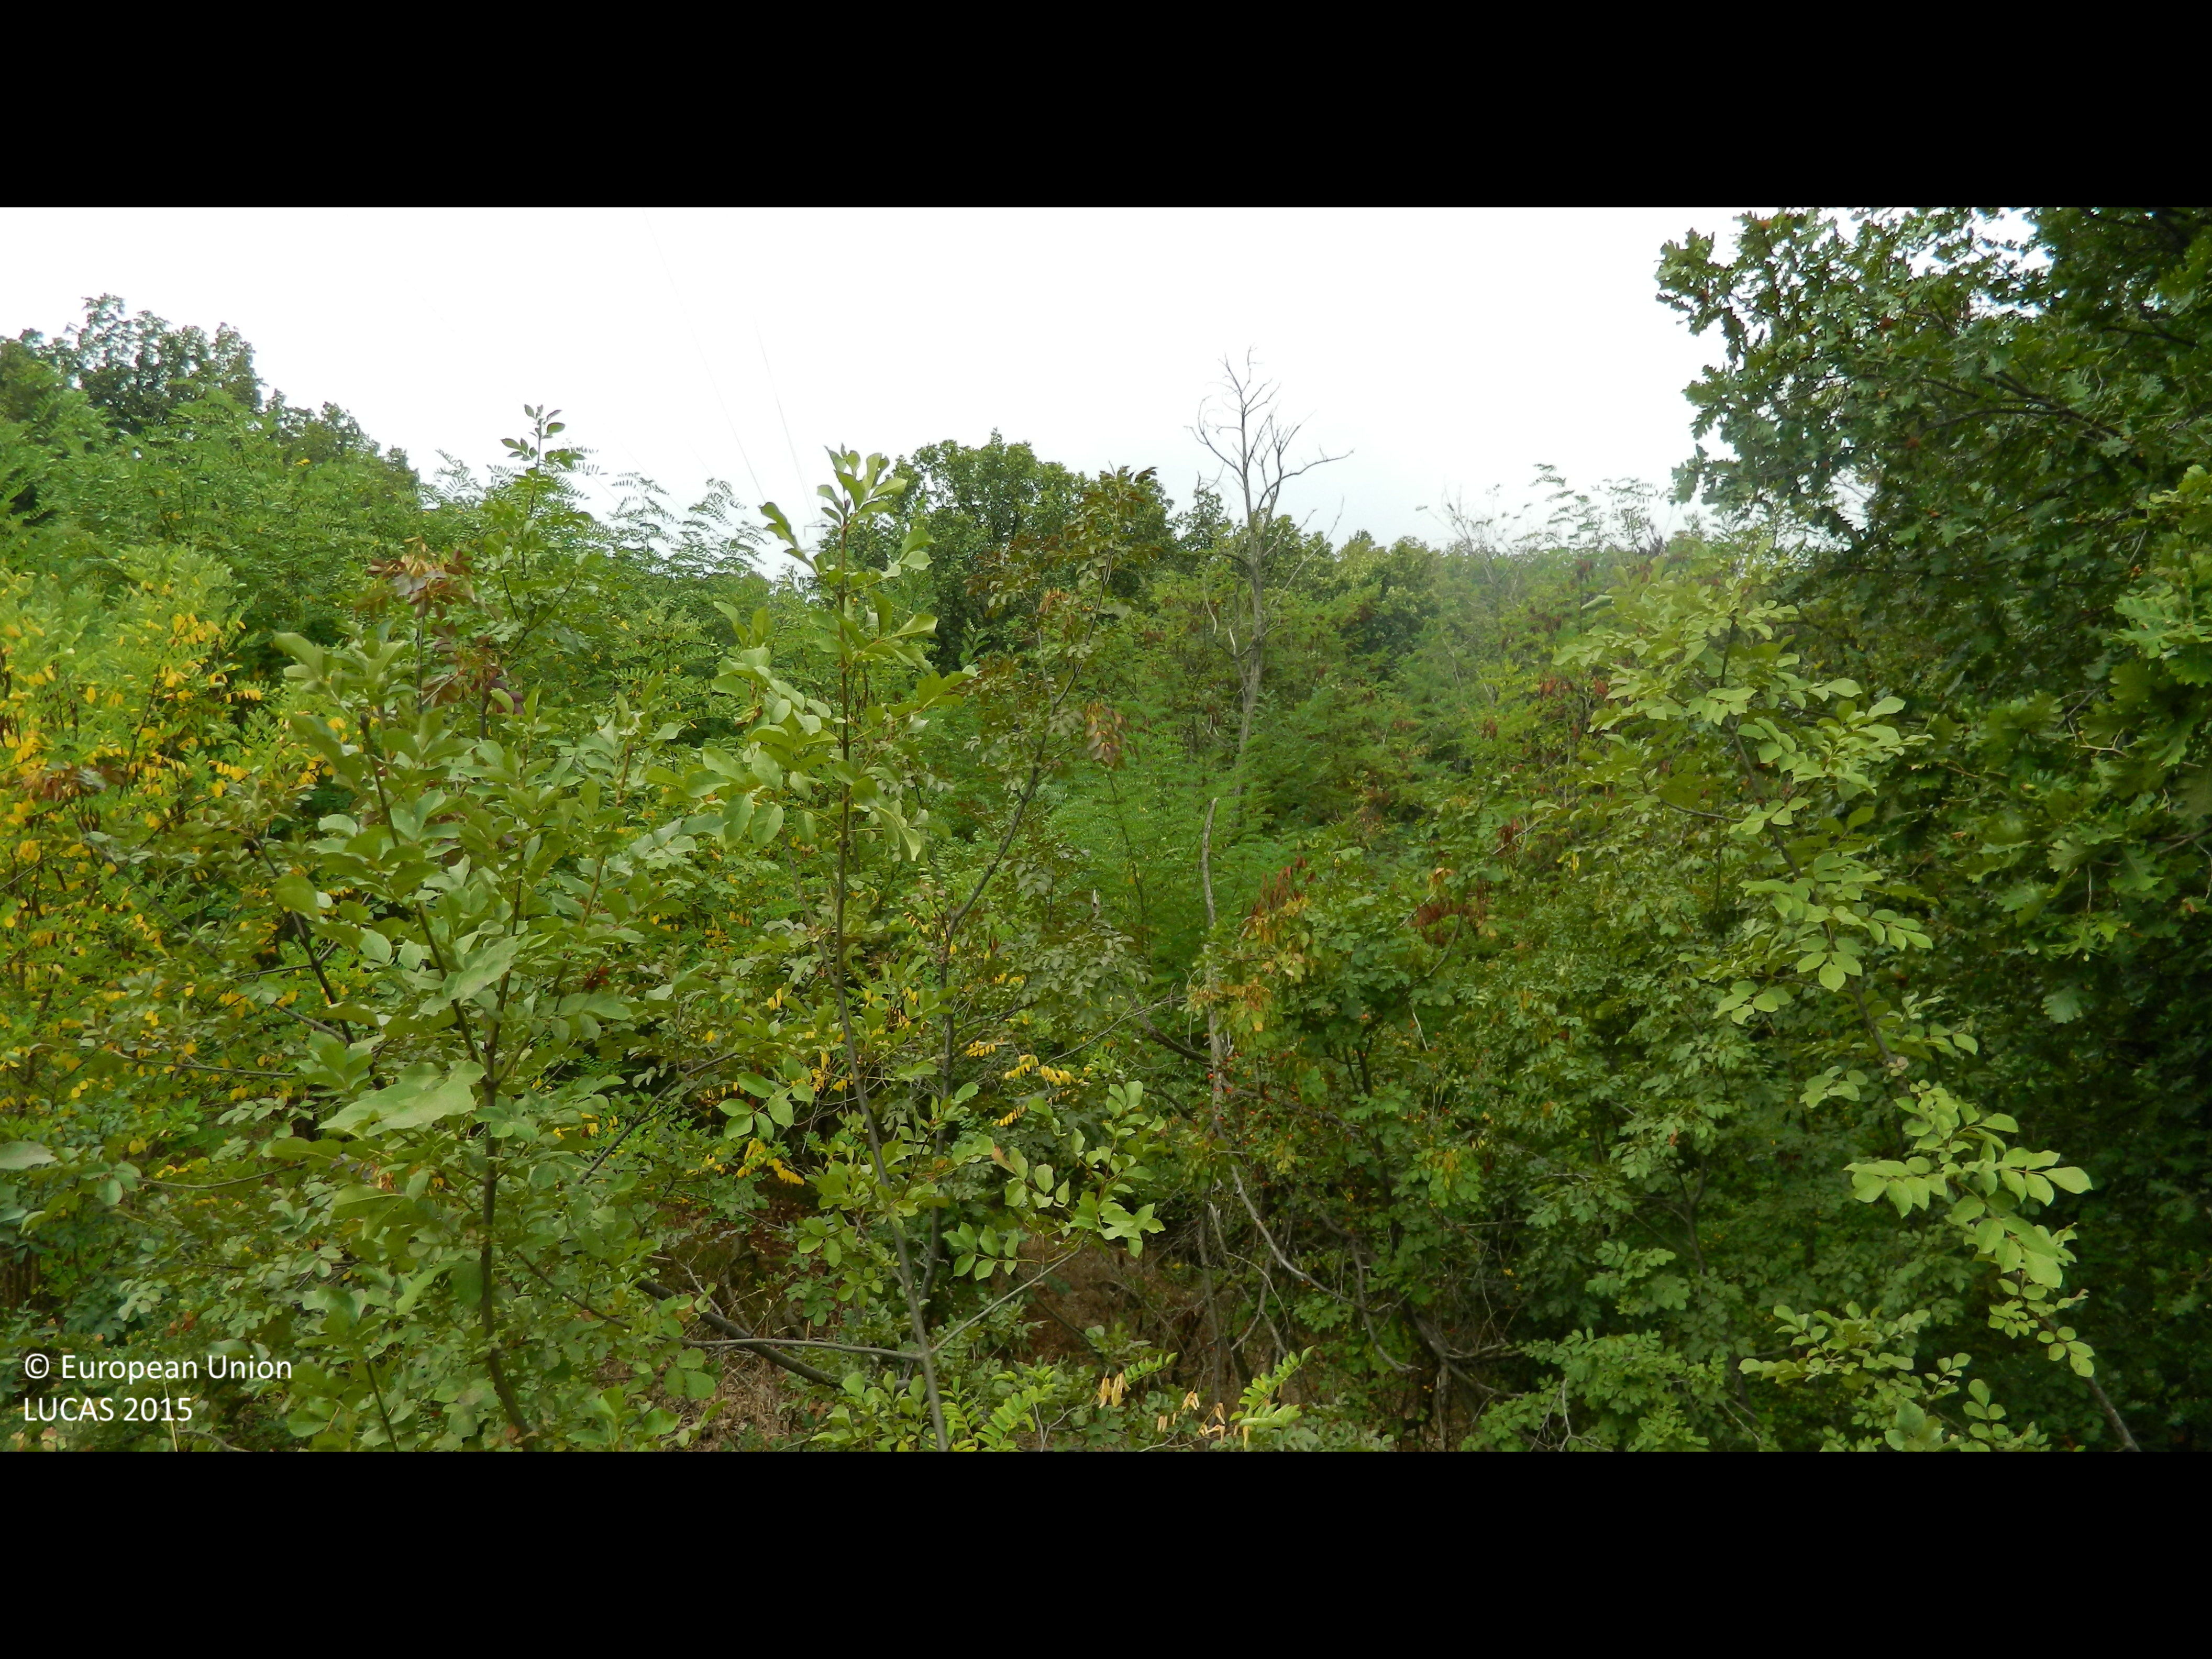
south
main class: Woodland
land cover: Broadleaved woodland
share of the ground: > 75 %
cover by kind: broadleaved forest trees 90 %, herbaceous plants 10 %
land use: Forestry
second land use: Electricity, gas and thermal power distribution
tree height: < 5 m
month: September
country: BG
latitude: 41.7913
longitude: 25.7952
